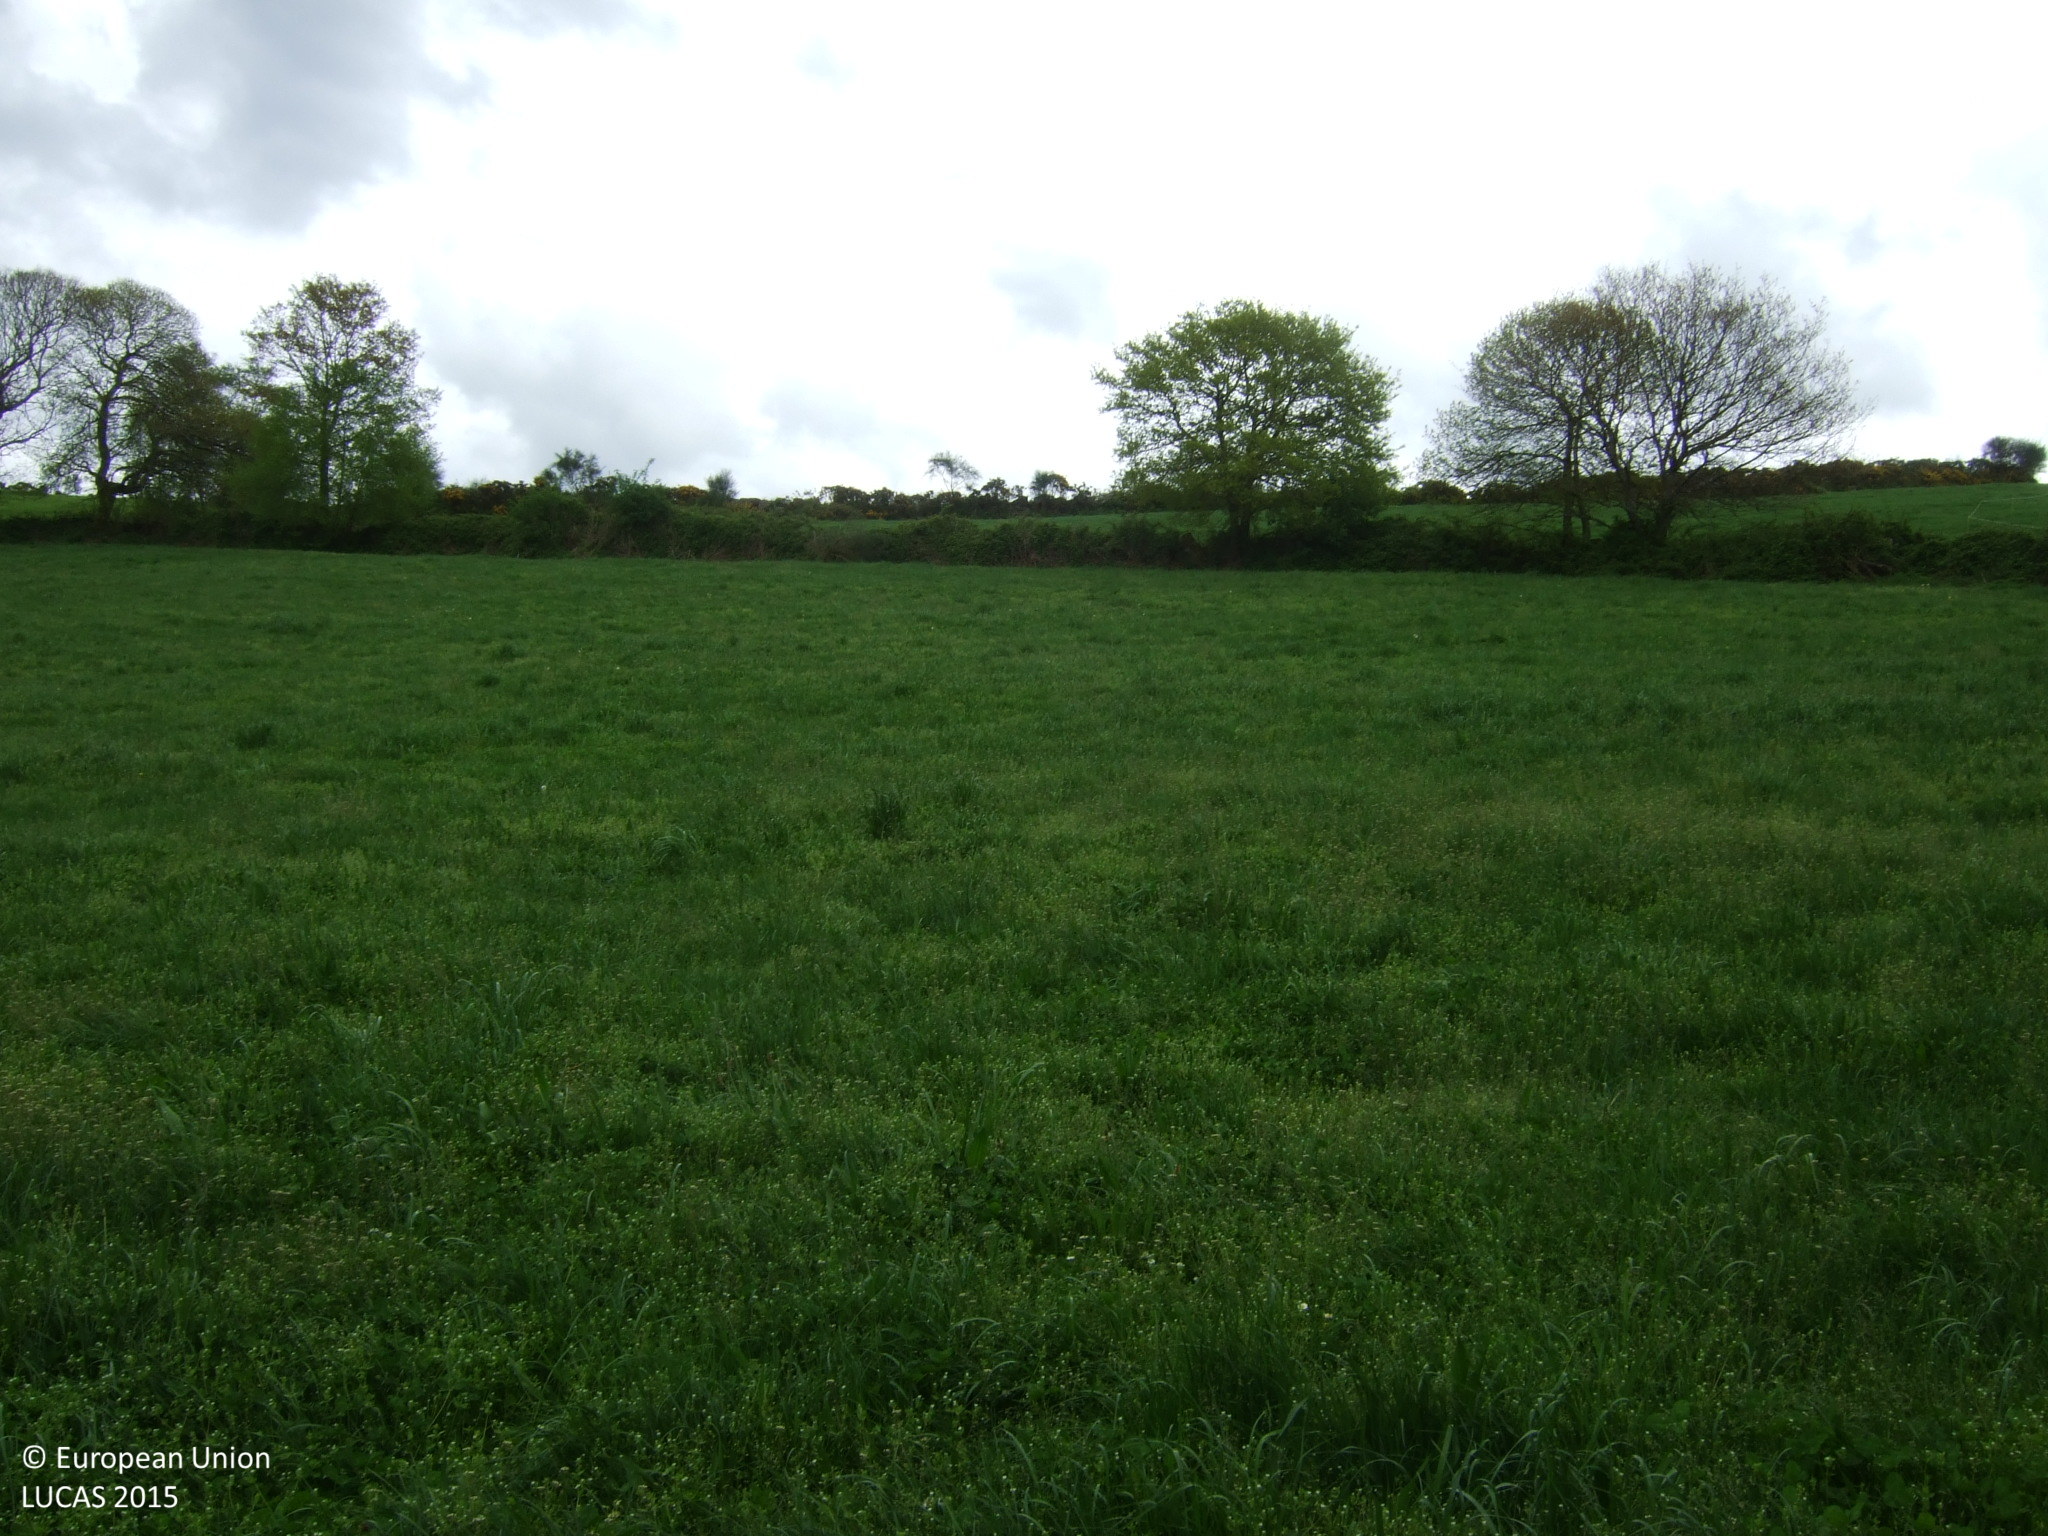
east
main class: Grassland
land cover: Grassland without tree/shrub cover
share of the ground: > 75 %
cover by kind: herbaceous plants 100 %
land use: Agriculture (excluding fallow land and kitchen gardens)
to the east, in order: Grassland without tree/shrub cover; Groves; Shruby margins; Grassland without tree/shrub cover; Shruby margins; Grassland without tree/shrub cover; Tracks; Shruby margins; Temporary grasslands; Shrubland without tree cover; Grassland without tree/shrub cover
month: April
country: ES
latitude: 42.9890
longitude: -7.8568
